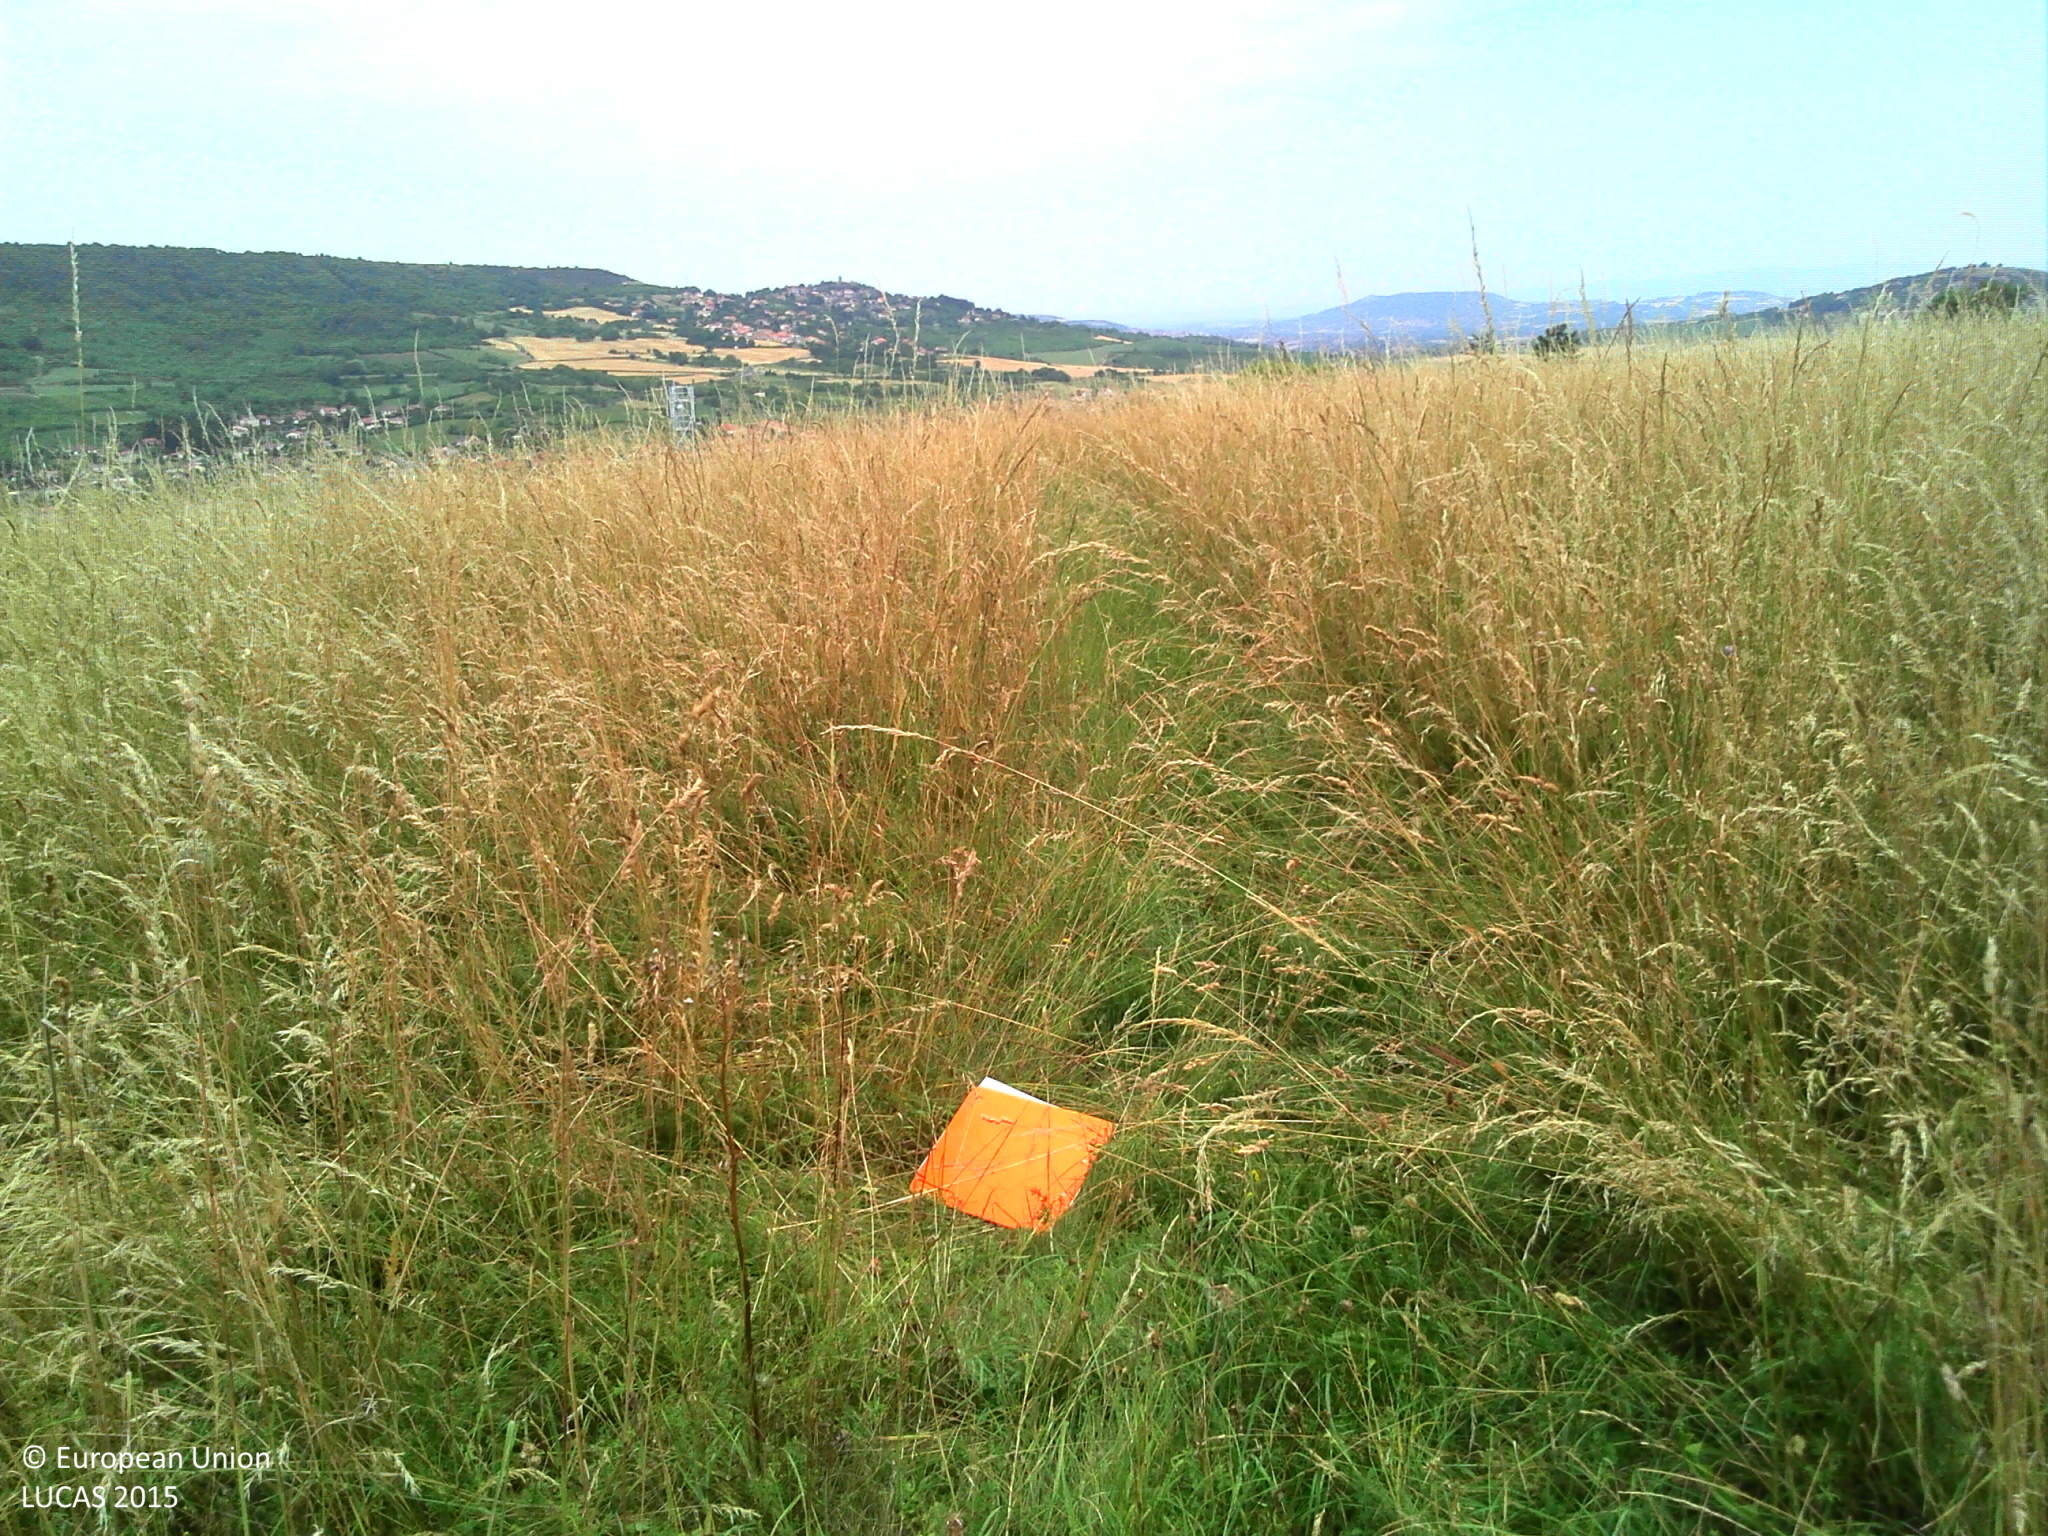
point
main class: Grassland
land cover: Grassland without tree/shrub cover
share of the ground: > 75 %
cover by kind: herbaceous plants 100 %
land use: Agriculture (excluding fallow land and kitchen gardens)
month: July
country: FR
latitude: 45.6588
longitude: 3.1084
